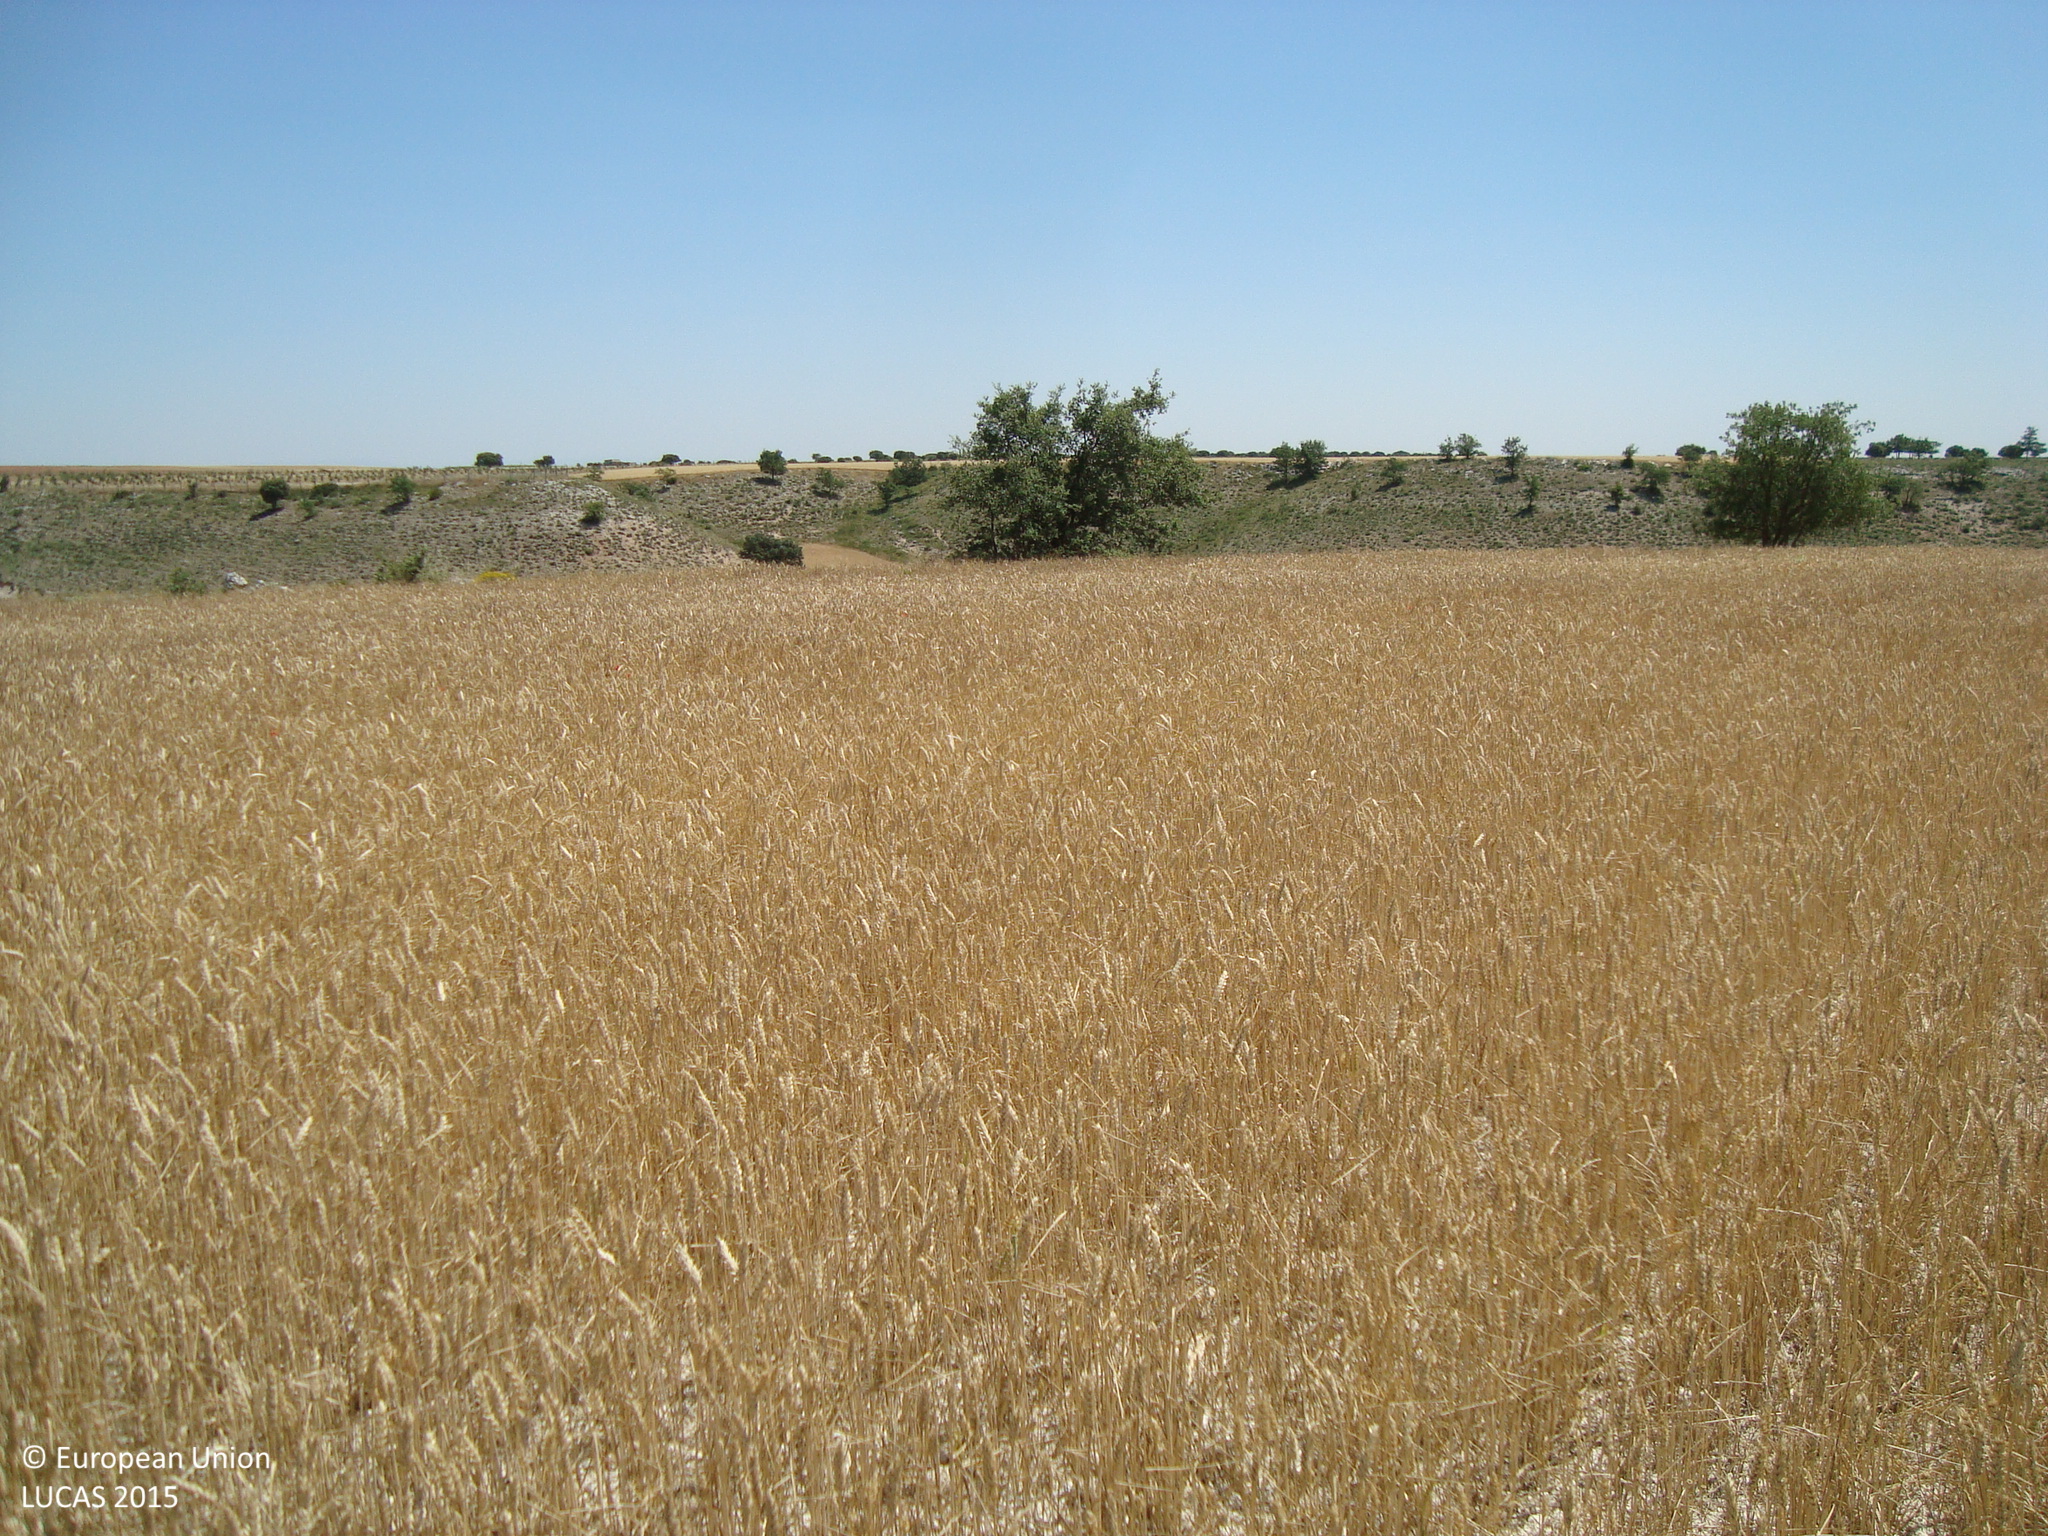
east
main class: Cropland
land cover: Common wheat
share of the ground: 50 - 75 %
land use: Agriculture (excluding fallow land and kitchen gardens)
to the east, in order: Common wheat; Grassland without tree/shrub cover; Other bare soil; Rivers and streams; Other bare soil; Grass margins; Tracks; Grass margins; Common wheat; Grassland with sparse tree/shrub cover
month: June
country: ES
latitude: 41.7798
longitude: -3.7833
